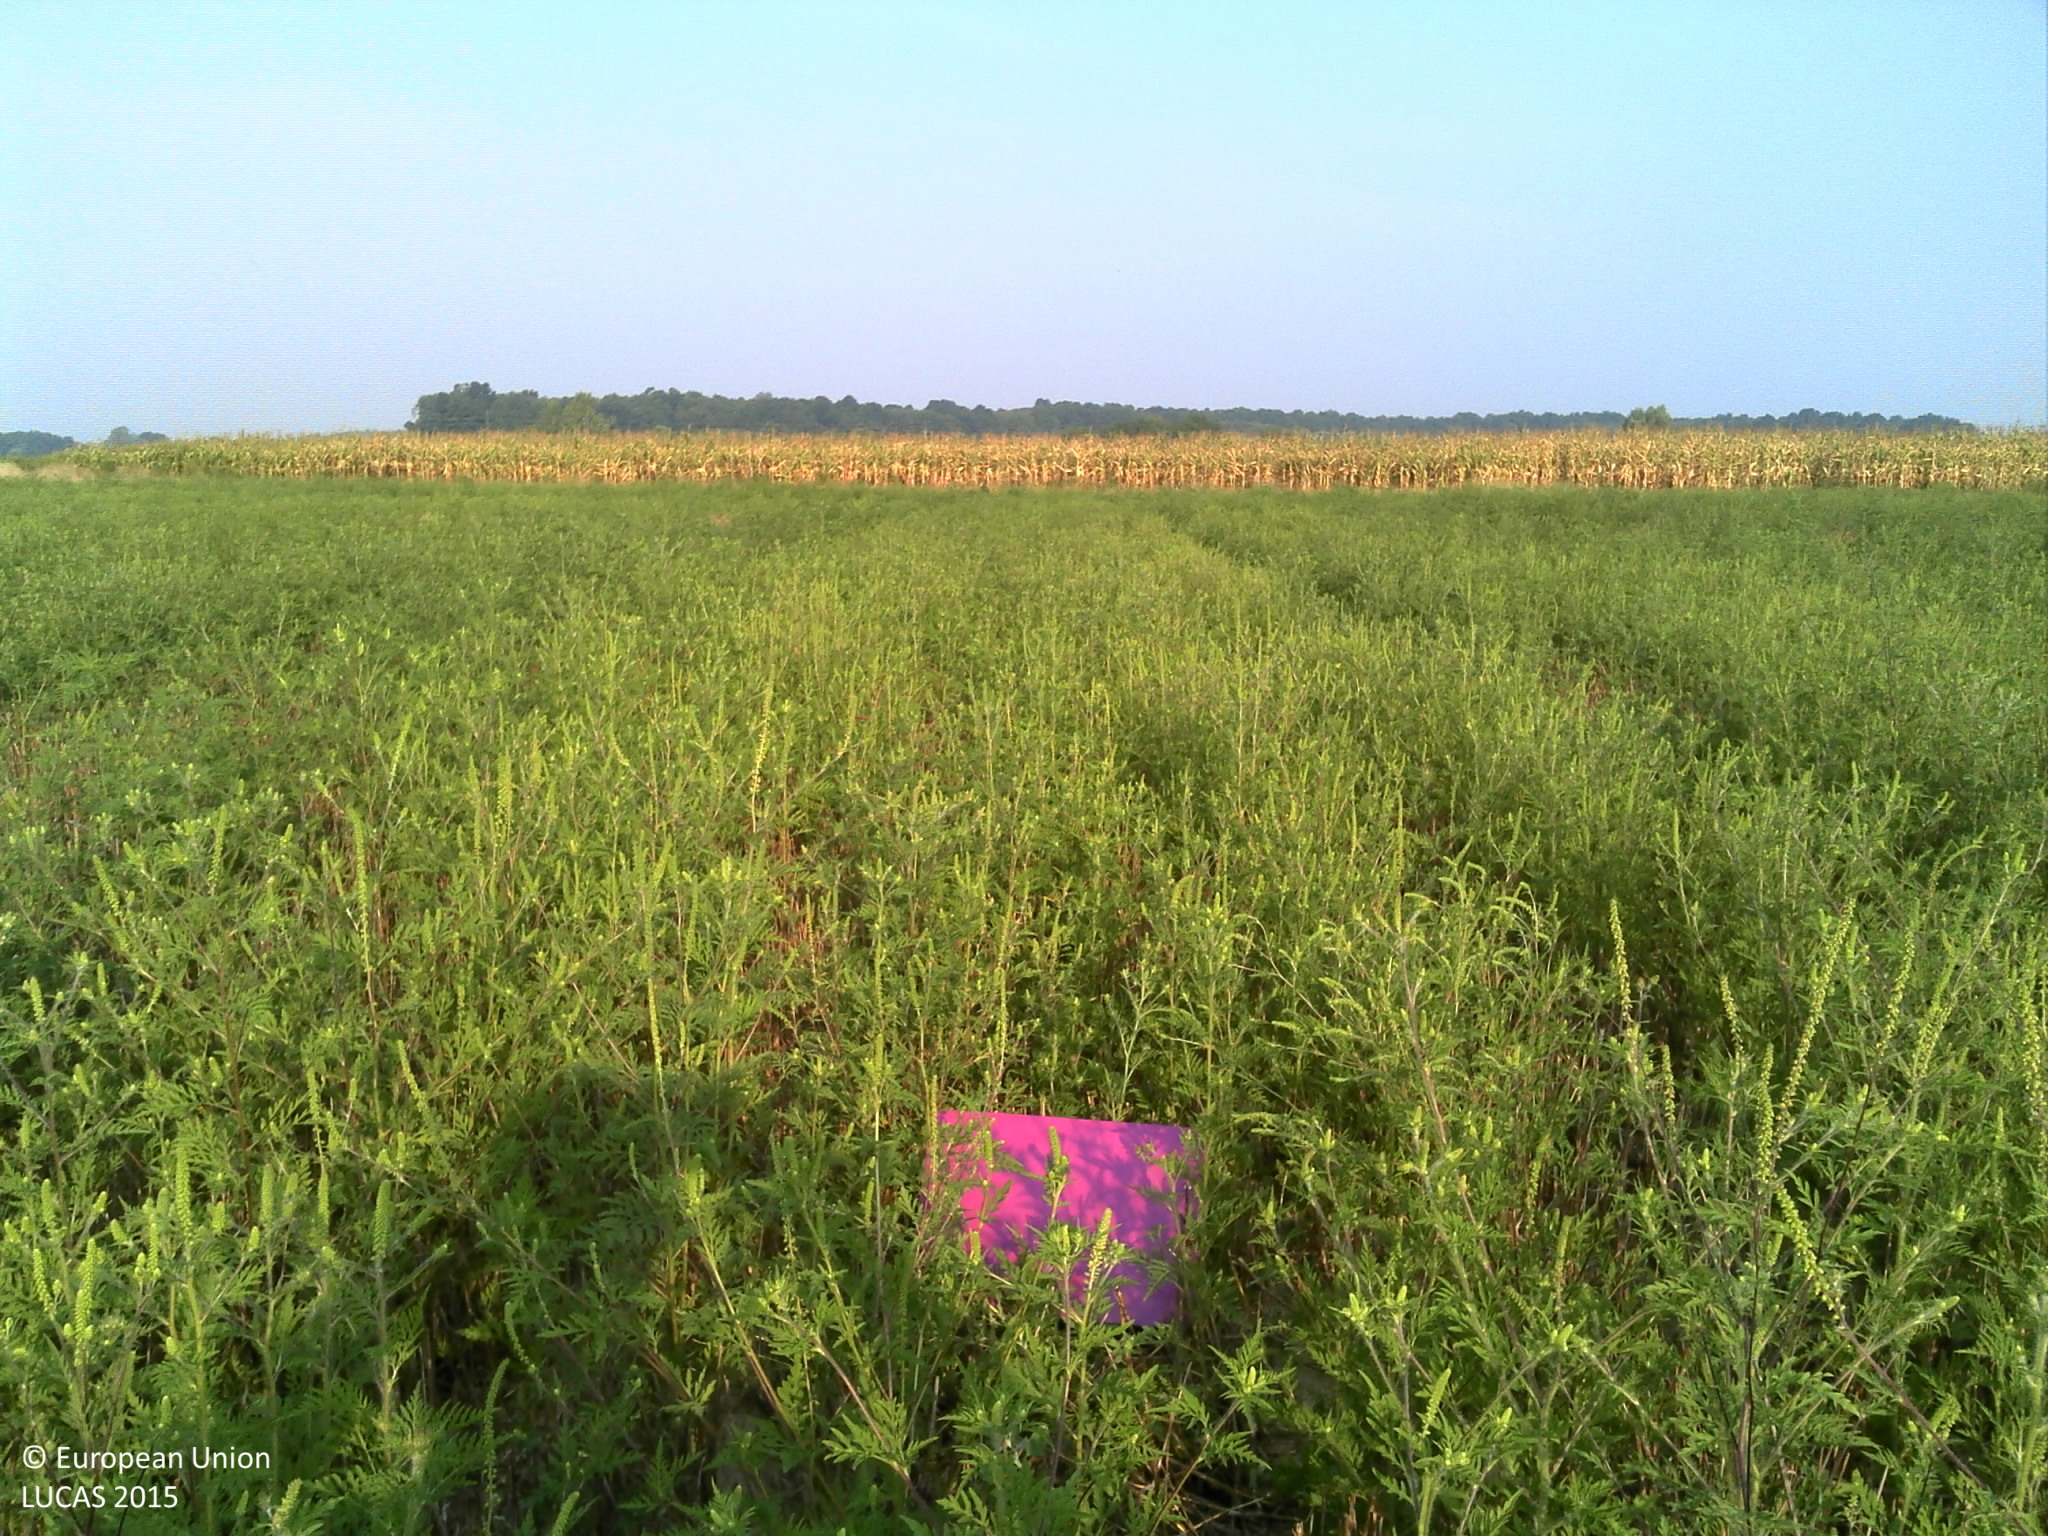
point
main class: Cropland
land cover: Common wheat
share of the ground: 10 - 25 %
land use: Agriculture (excluding fallow land and kitchen gardens)
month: August
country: HR
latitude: 45.9806
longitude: 17.2176
